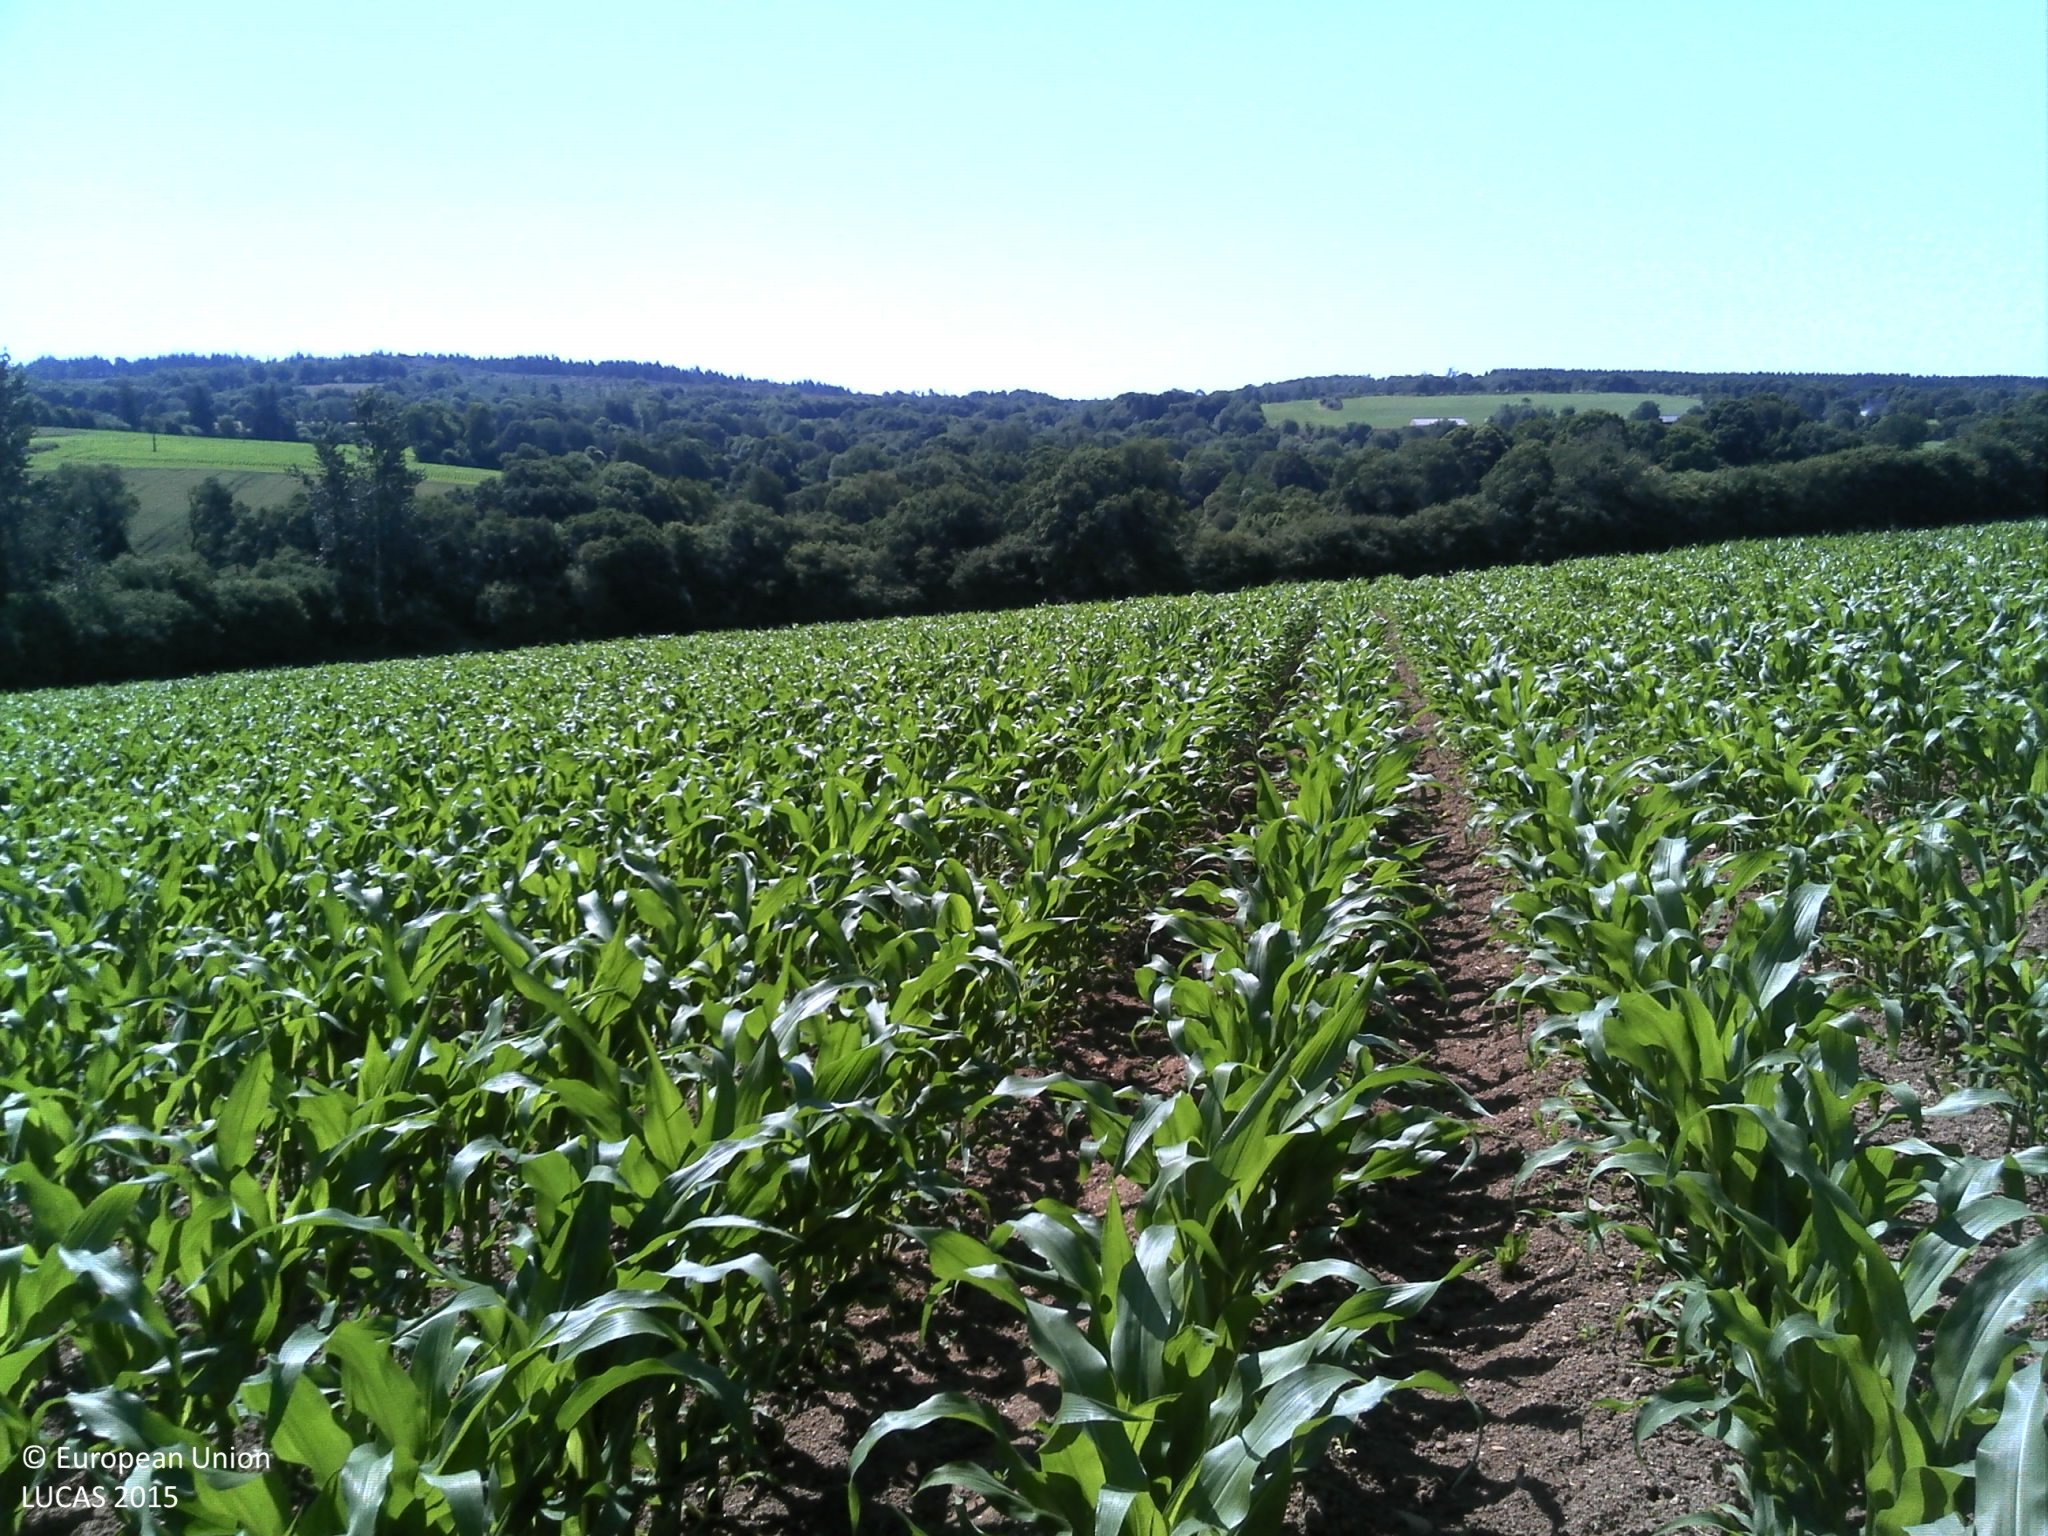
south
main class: Cropland
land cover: Maize
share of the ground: 50 - 75 %
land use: Agriculture (excluding fallow land and kitchen gardens)
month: June
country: FR
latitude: 48.1935
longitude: -3.6270
